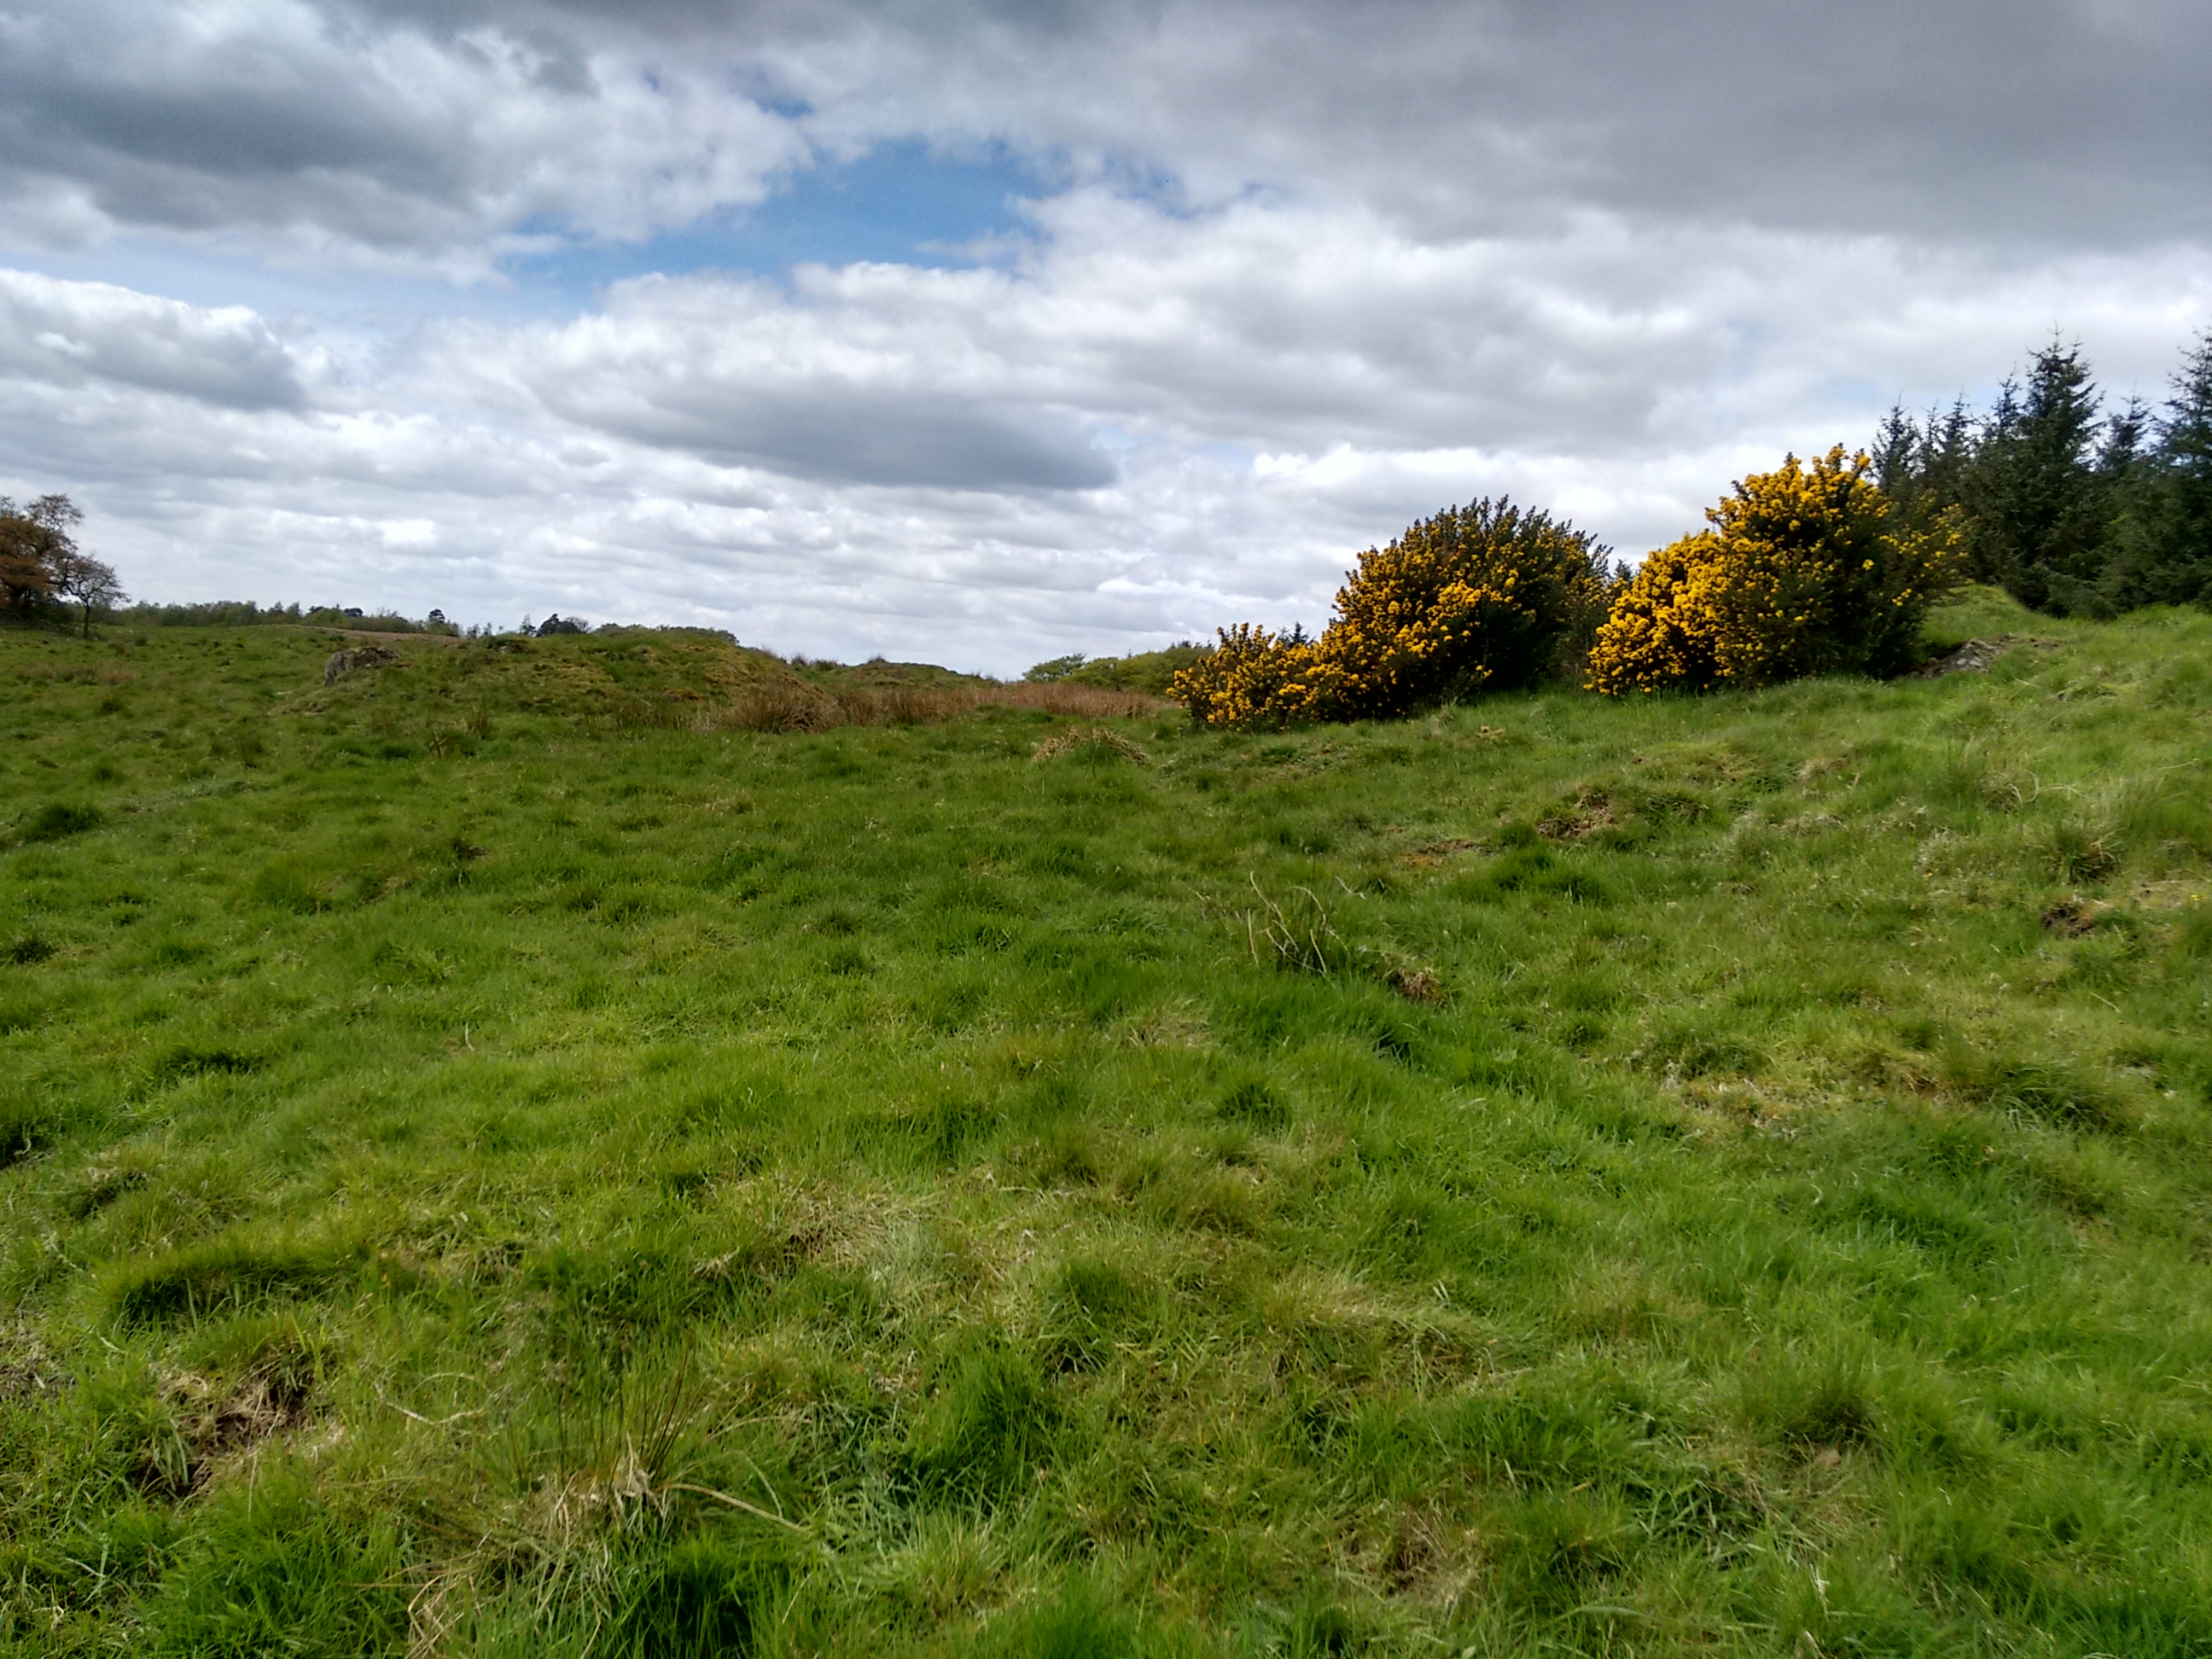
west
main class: Grassland
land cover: Grassland without tree/shrub cover
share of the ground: > 75 %
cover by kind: herbaceous plants 100 %
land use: Agriculture (excluding fallow land and kitchen gardens)
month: May
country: GB
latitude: 55.9476
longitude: -3.6432
